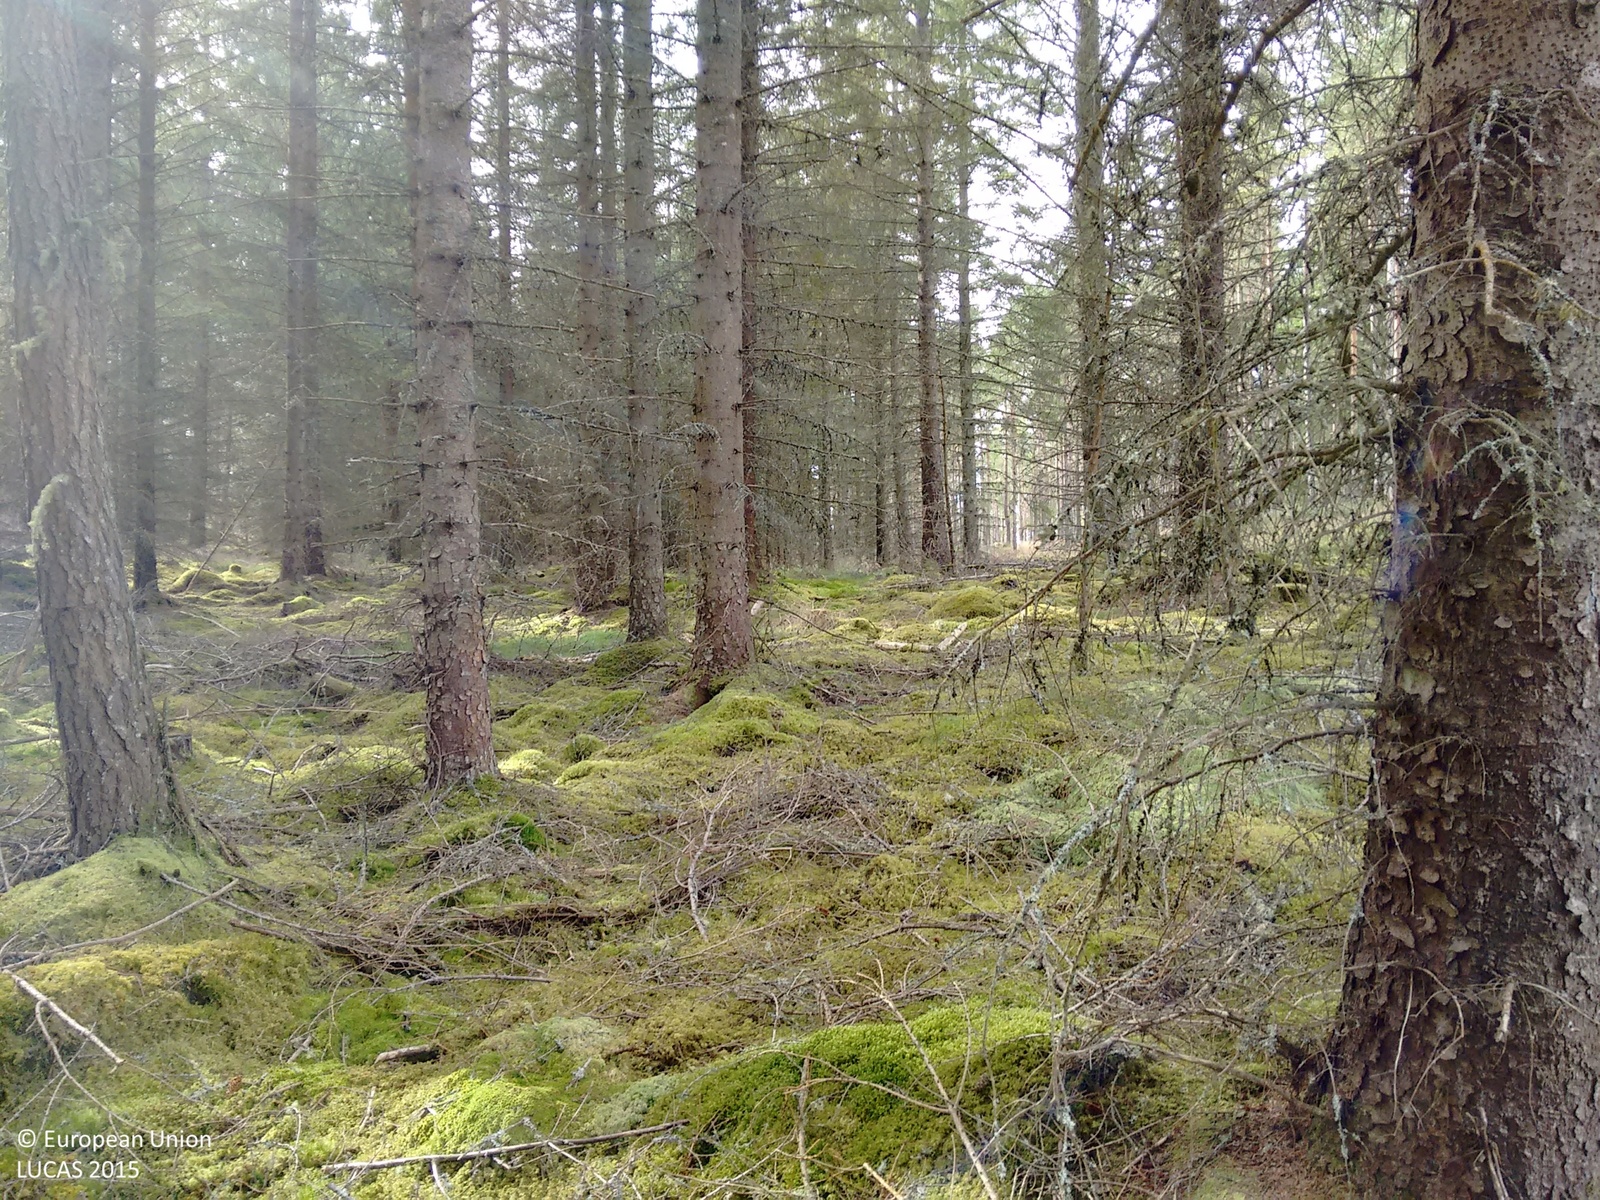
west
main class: Woodland
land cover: Spruce dominated coniferous woodland
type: exotic forest
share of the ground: > 75 %
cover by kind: coniferous forest trees 100 %
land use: Forestry
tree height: > 5 m
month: September
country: GB
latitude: 57.5714
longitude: -4.5204
